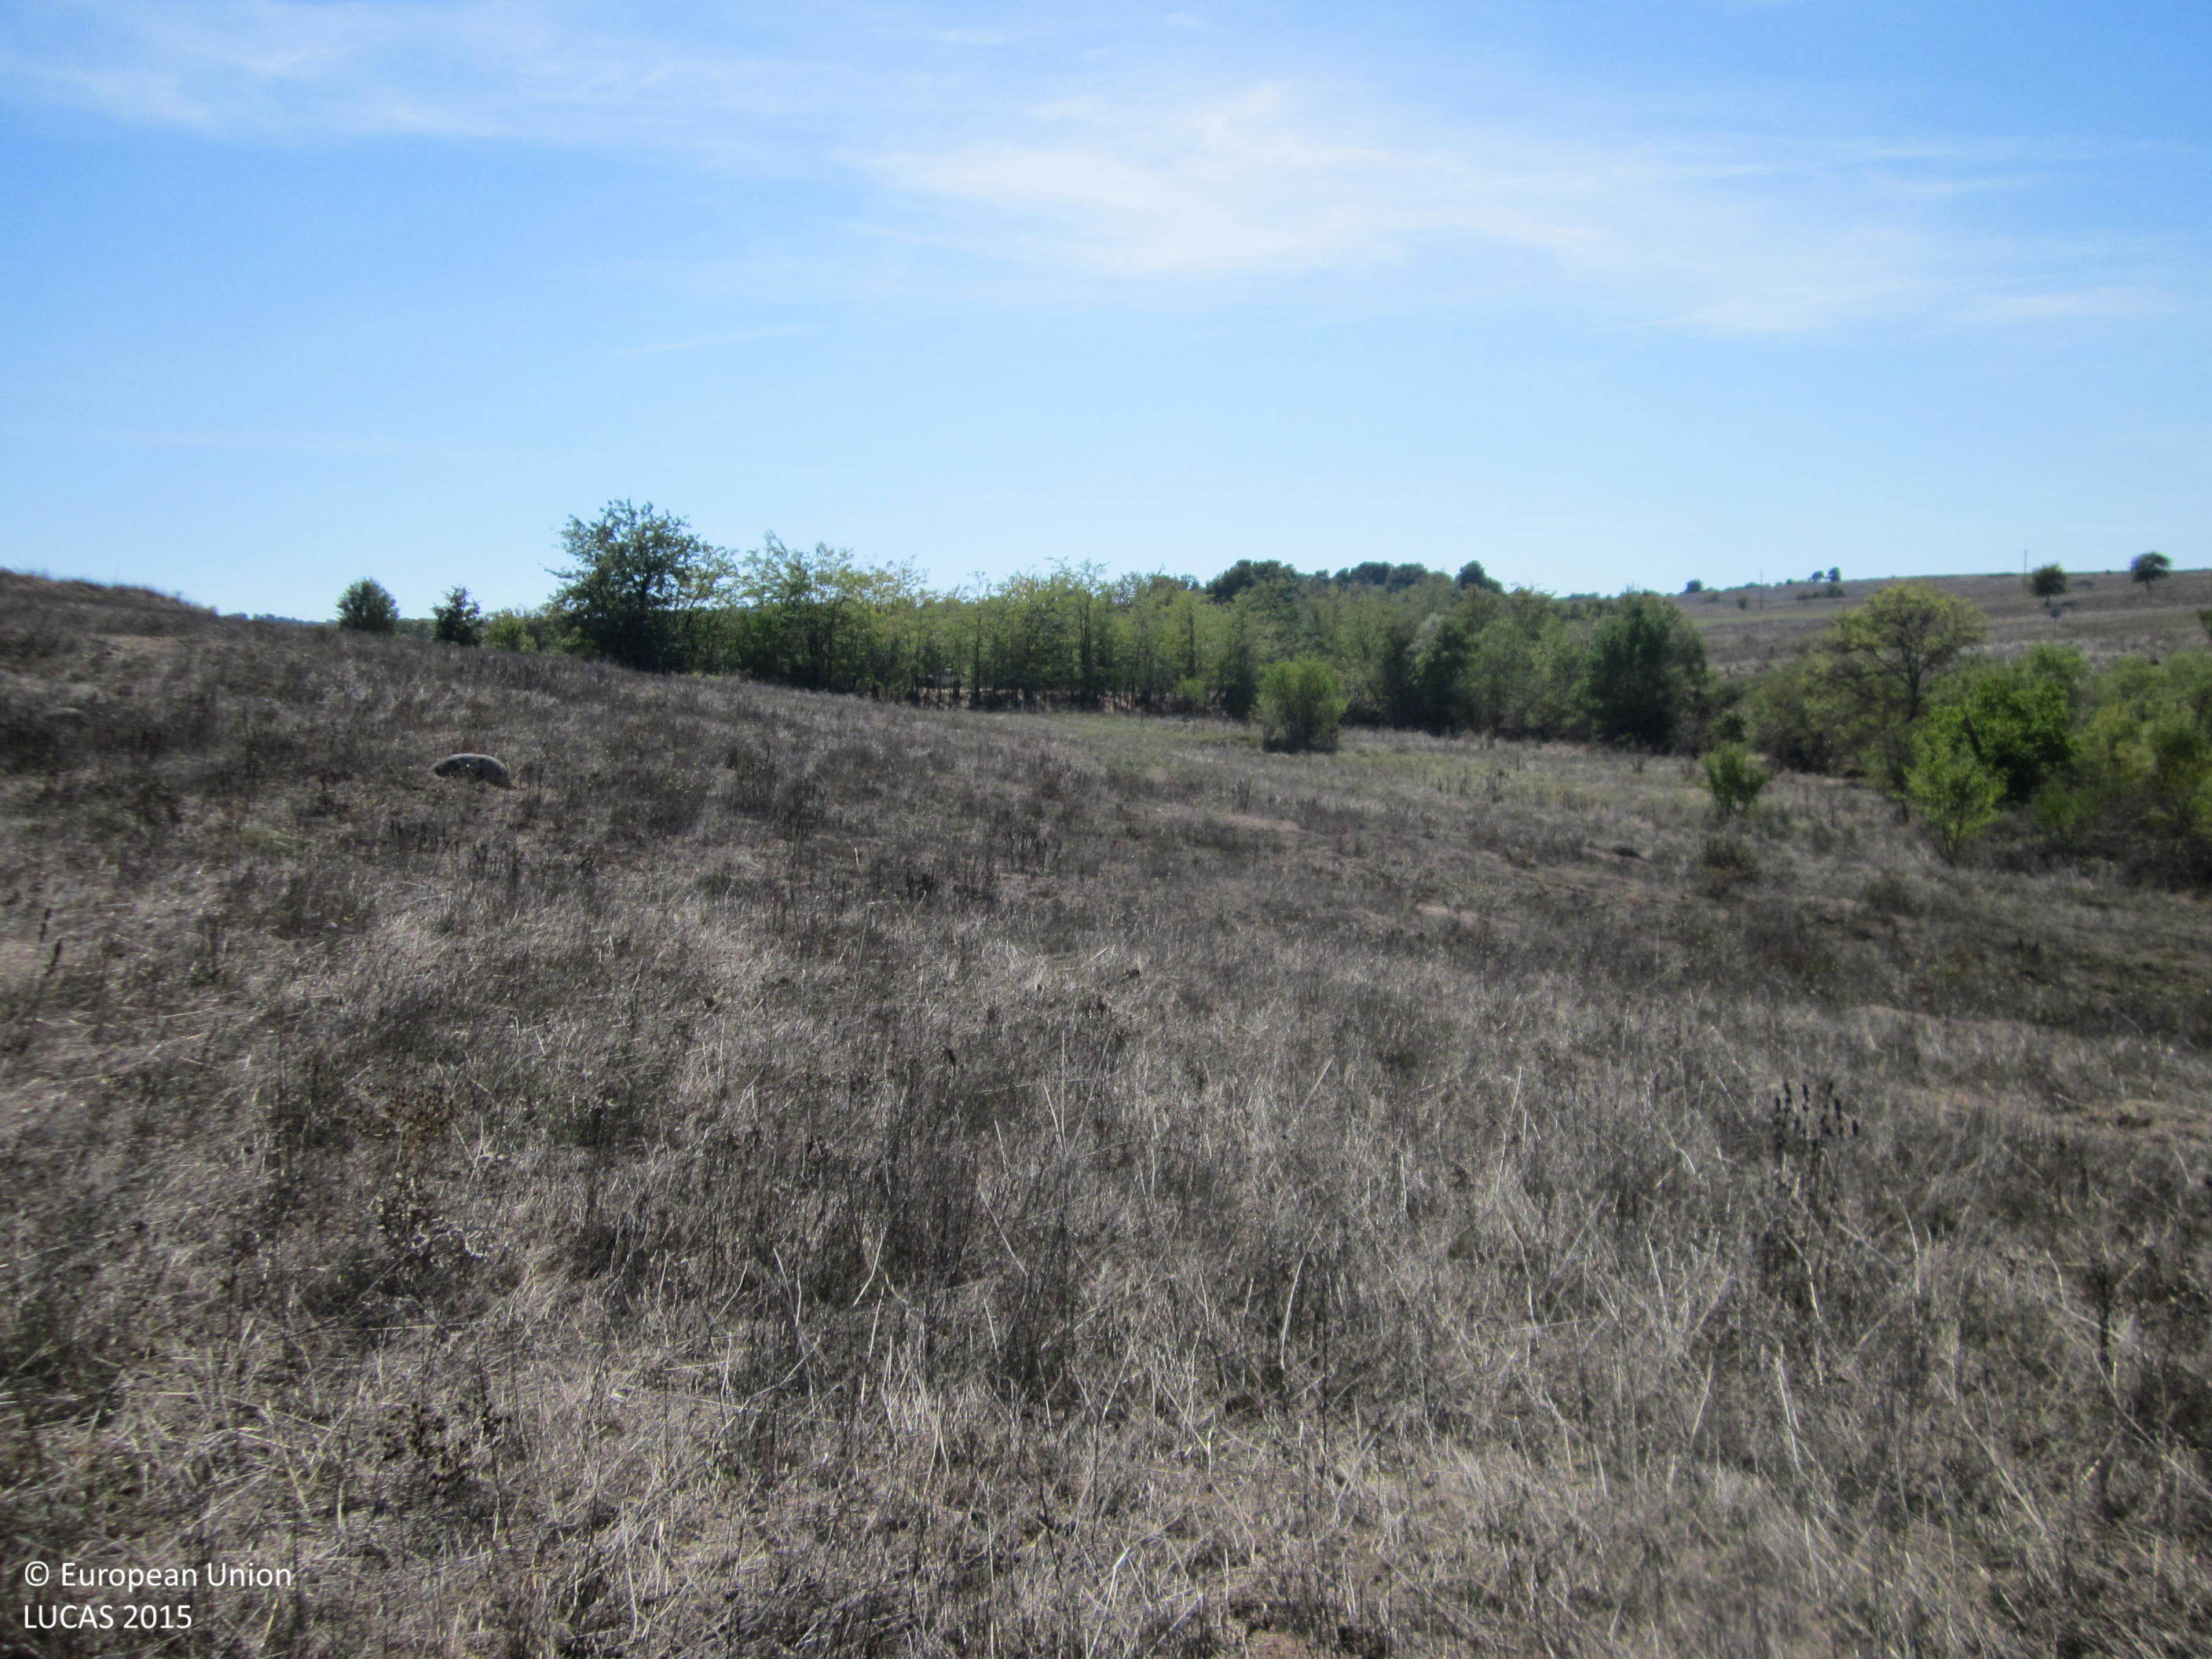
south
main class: Grassland
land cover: Grassland without tree/shrub cover
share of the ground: > 75 %
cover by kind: herbaceous plants 100 %
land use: Agriculture (excluding fallow land and kitchen gardens)
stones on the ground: < 10 %
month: September
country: BG
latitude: 42.2565
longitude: 26.9864
